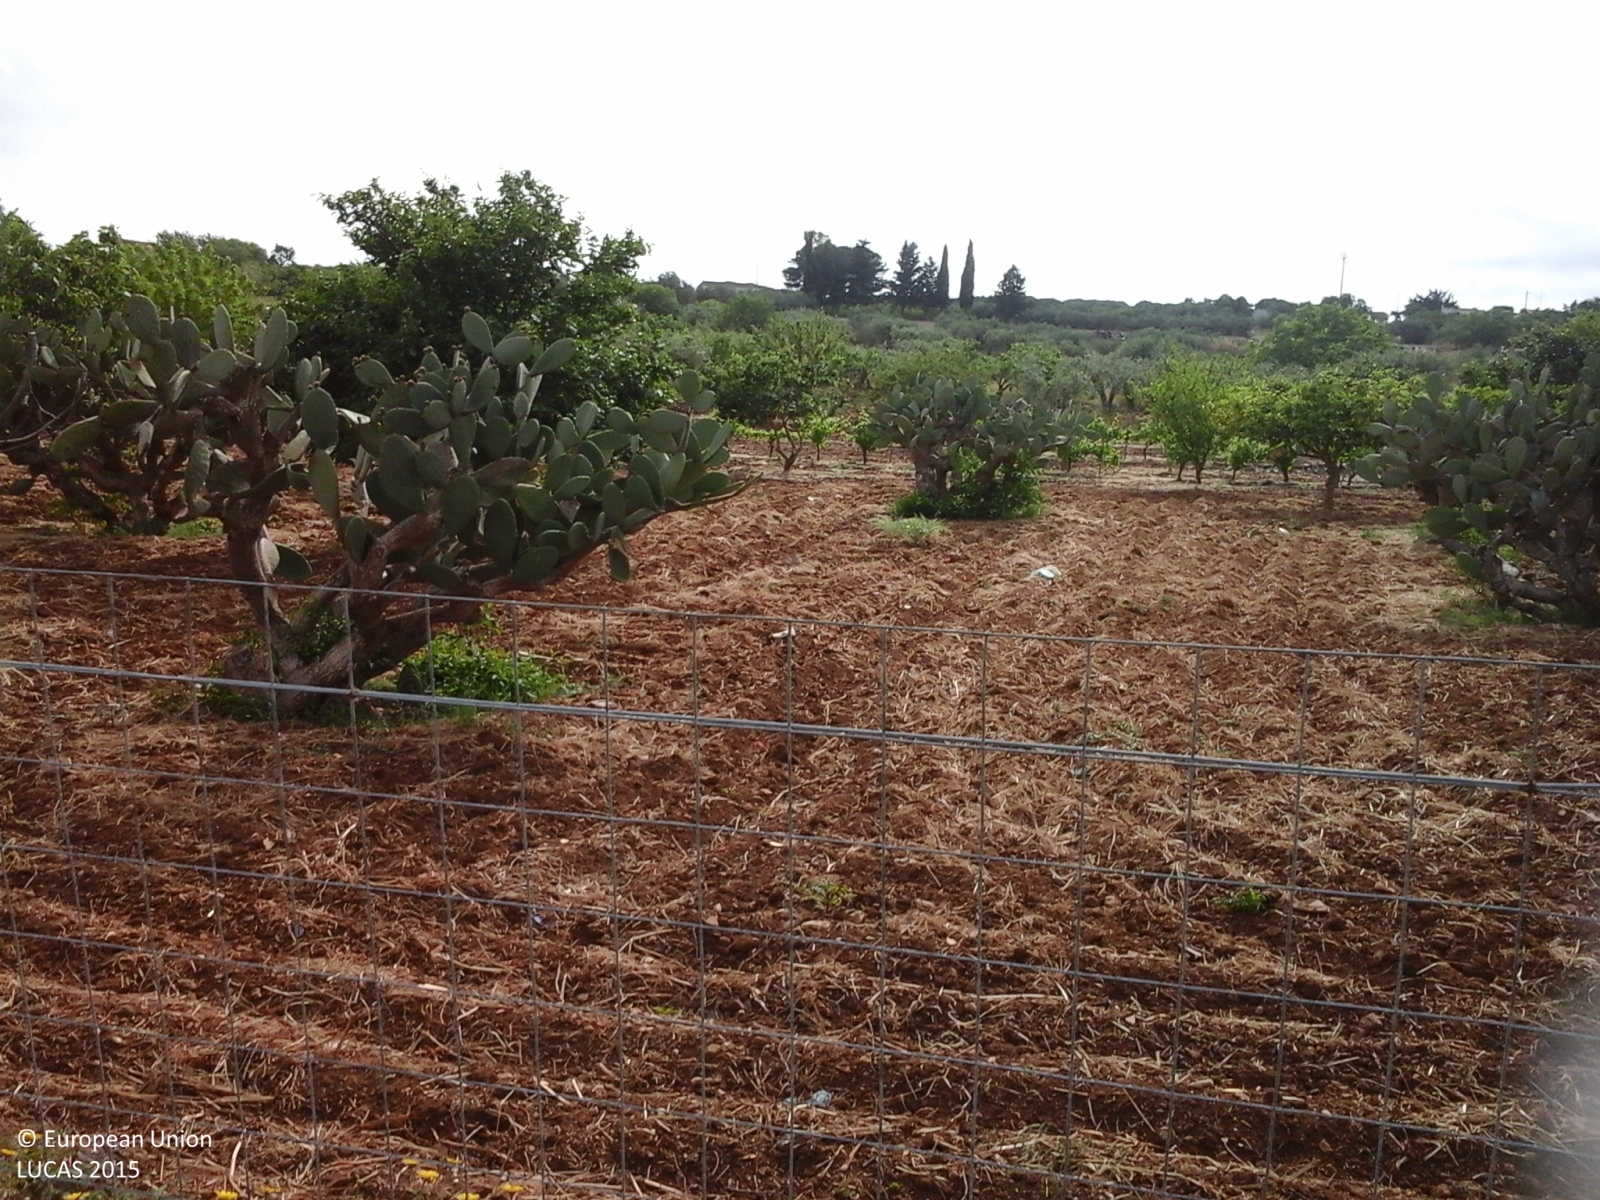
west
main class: Cropland
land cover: Olive groves
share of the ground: 50 - 75 %
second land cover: Other bare soil
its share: > 75 %
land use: Agriculture (excluding fallow land and kitchen gardens)
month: May
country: IT
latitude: 37.6819
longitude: 13.0049
